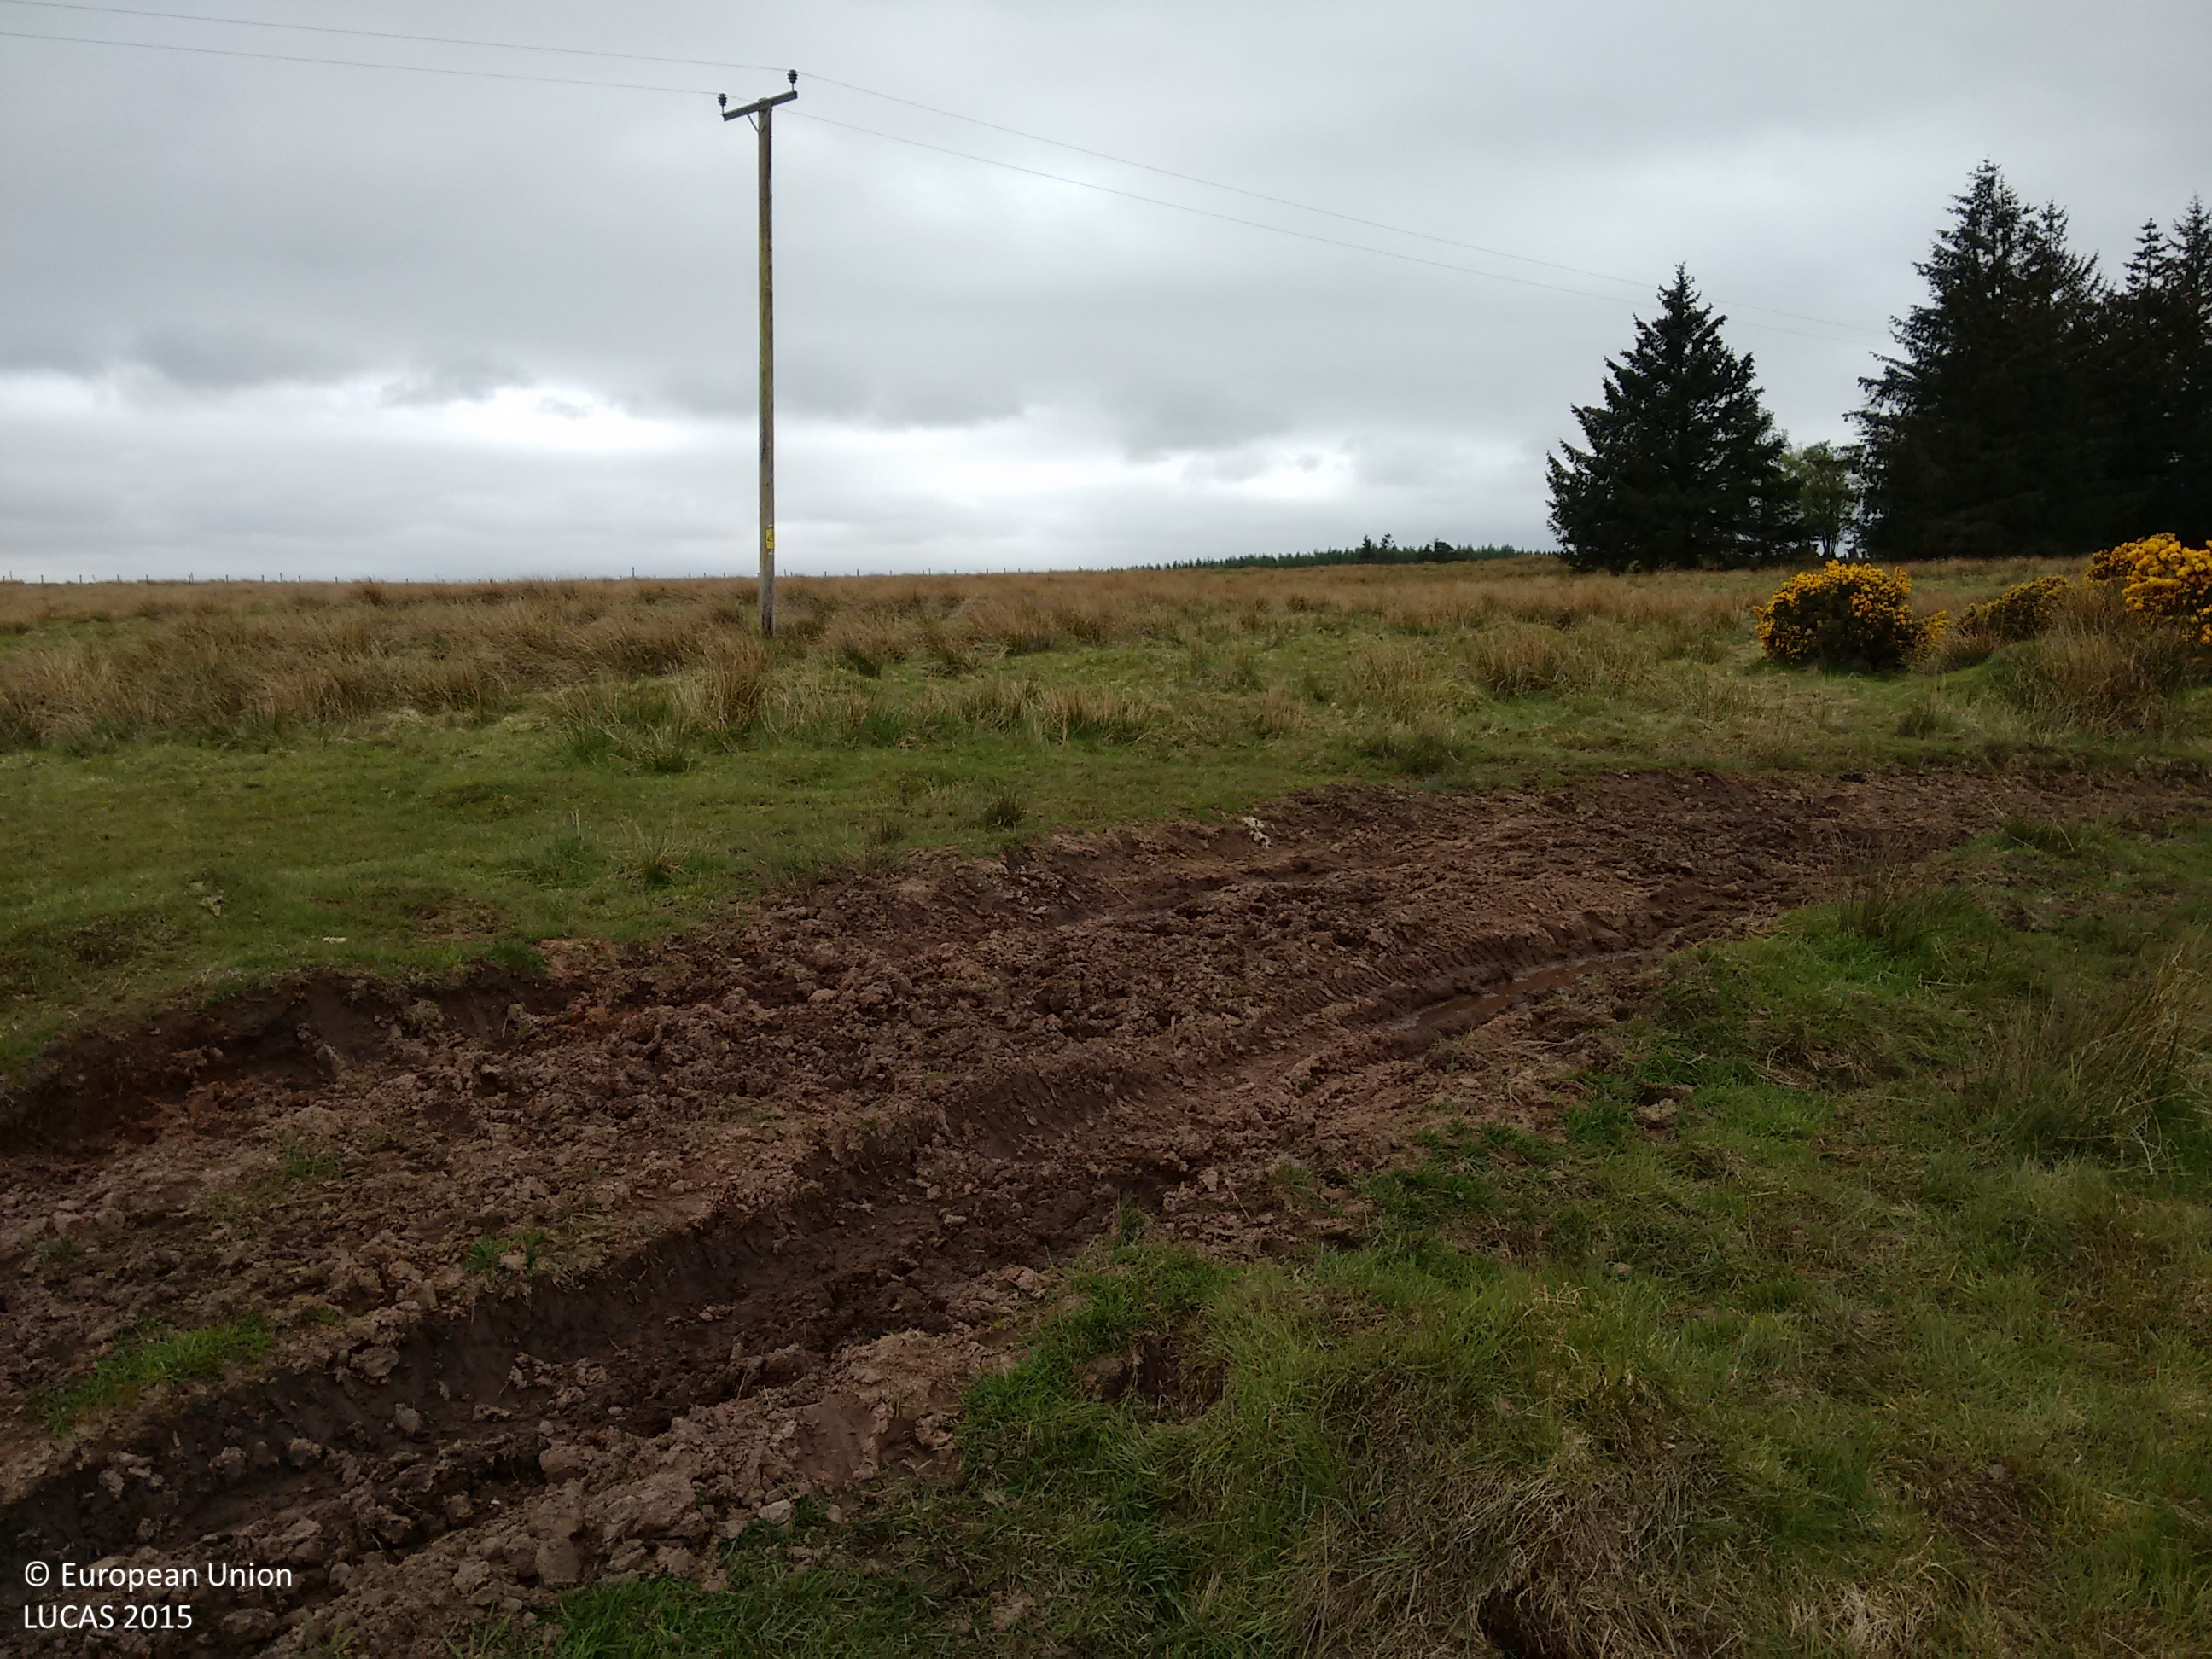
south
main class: Grassland
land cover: Grassland with sparse tree/shrub cover
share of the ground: > 75 %
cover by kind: herbaceous plants 85 %, broadleaved forest trees 5 %, shrubs 5 %, consolidated bare surface 5 %
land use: Agriculture (excluding fallow land and kitchen gardens)
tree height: > 5 m
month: May
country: GB
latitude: 56.2960
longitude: -3.8006
